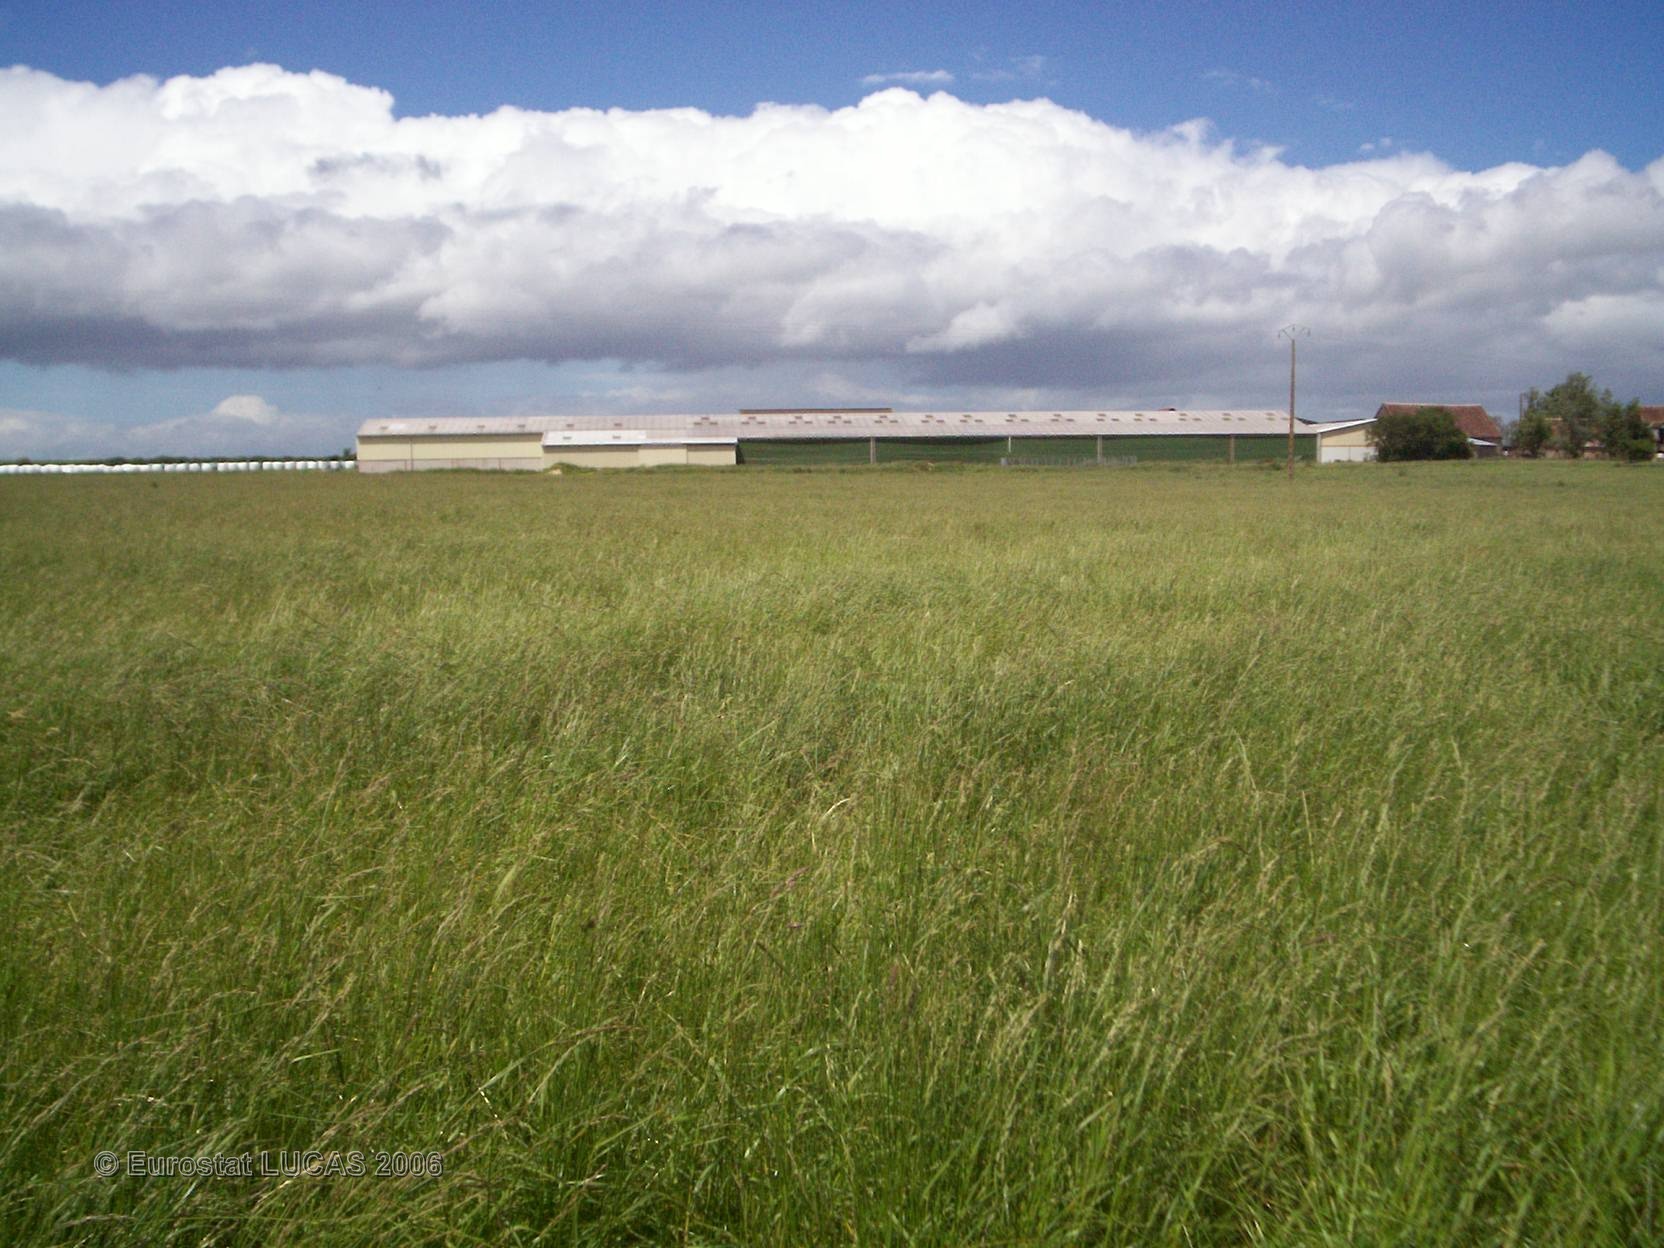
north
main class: Grassland
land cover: Grassland without tree/shrub cover
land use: Agriculture (excluding fallow land and kitchen gardens)
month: May
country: FR
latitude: 47.6241
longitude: 0.8393
